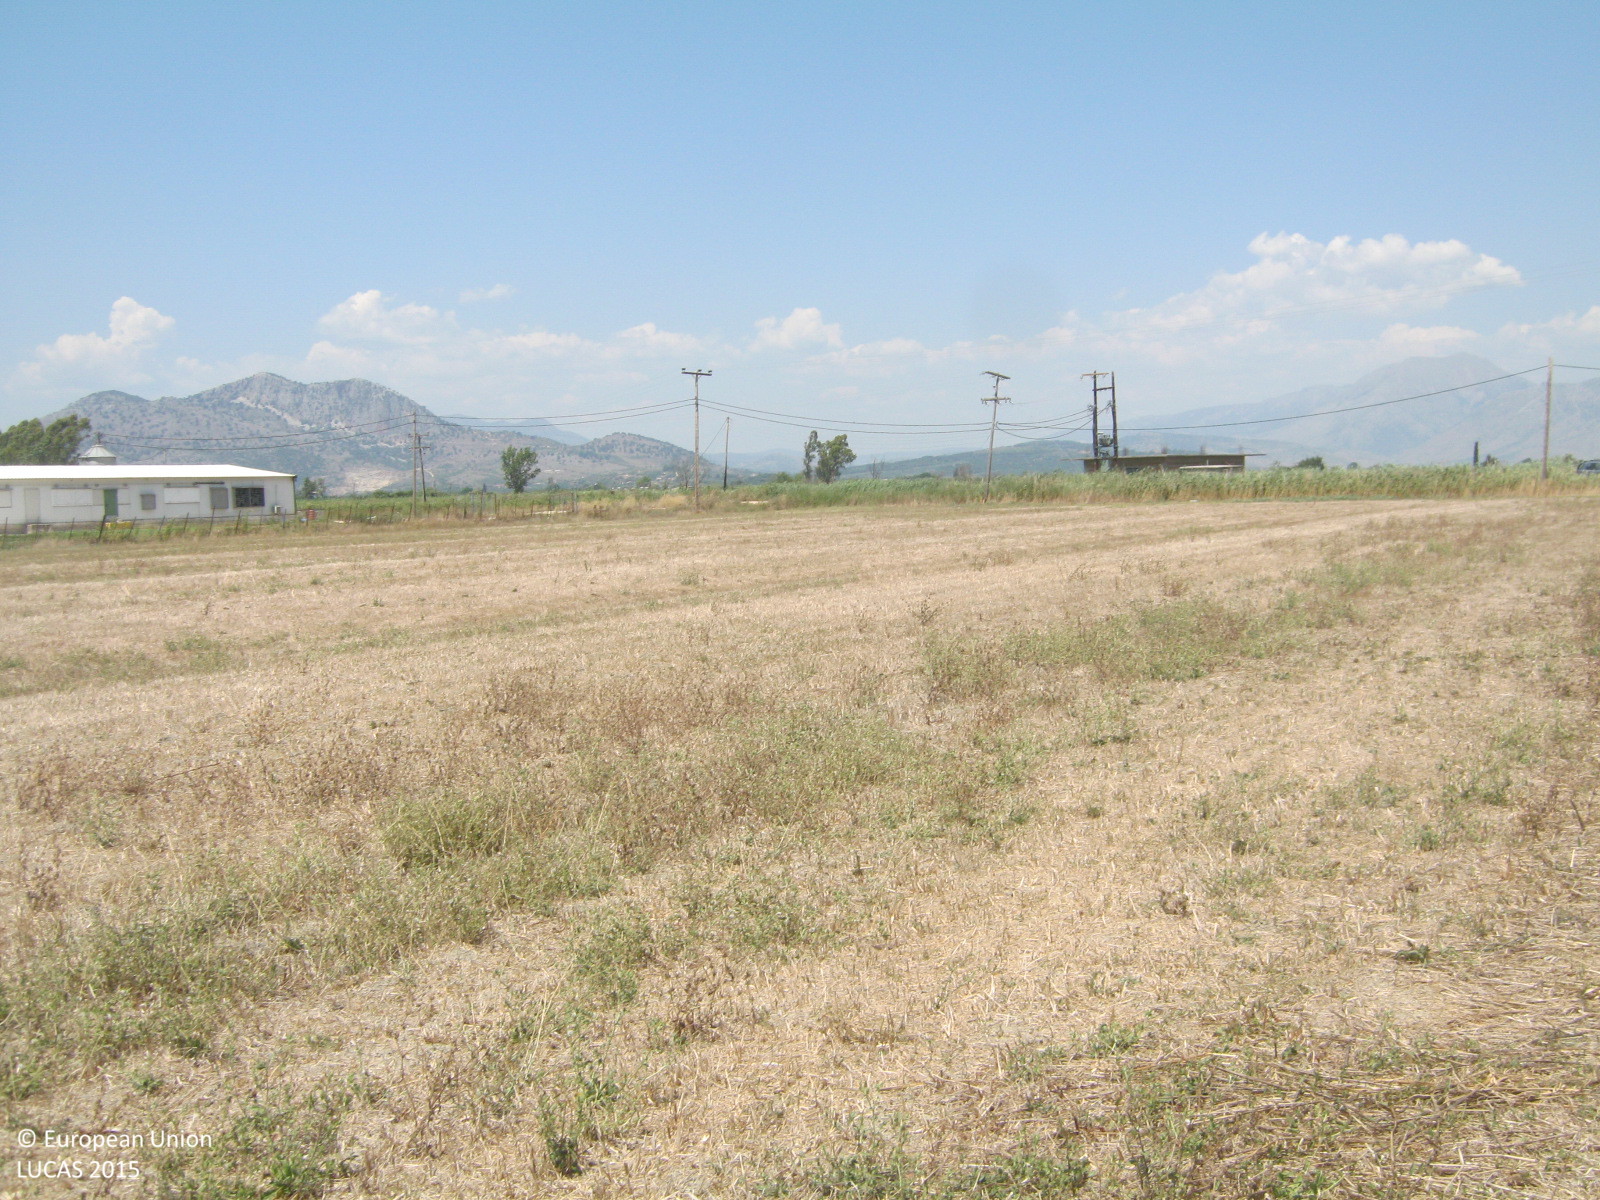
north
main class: Grassland
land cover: Spontaneously vegetated surfaces
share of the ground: > 75 %
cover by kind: herbaceous plants 100 %
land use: Fallow land
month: July
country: GR
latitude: 39.1157
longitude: 20.8558
